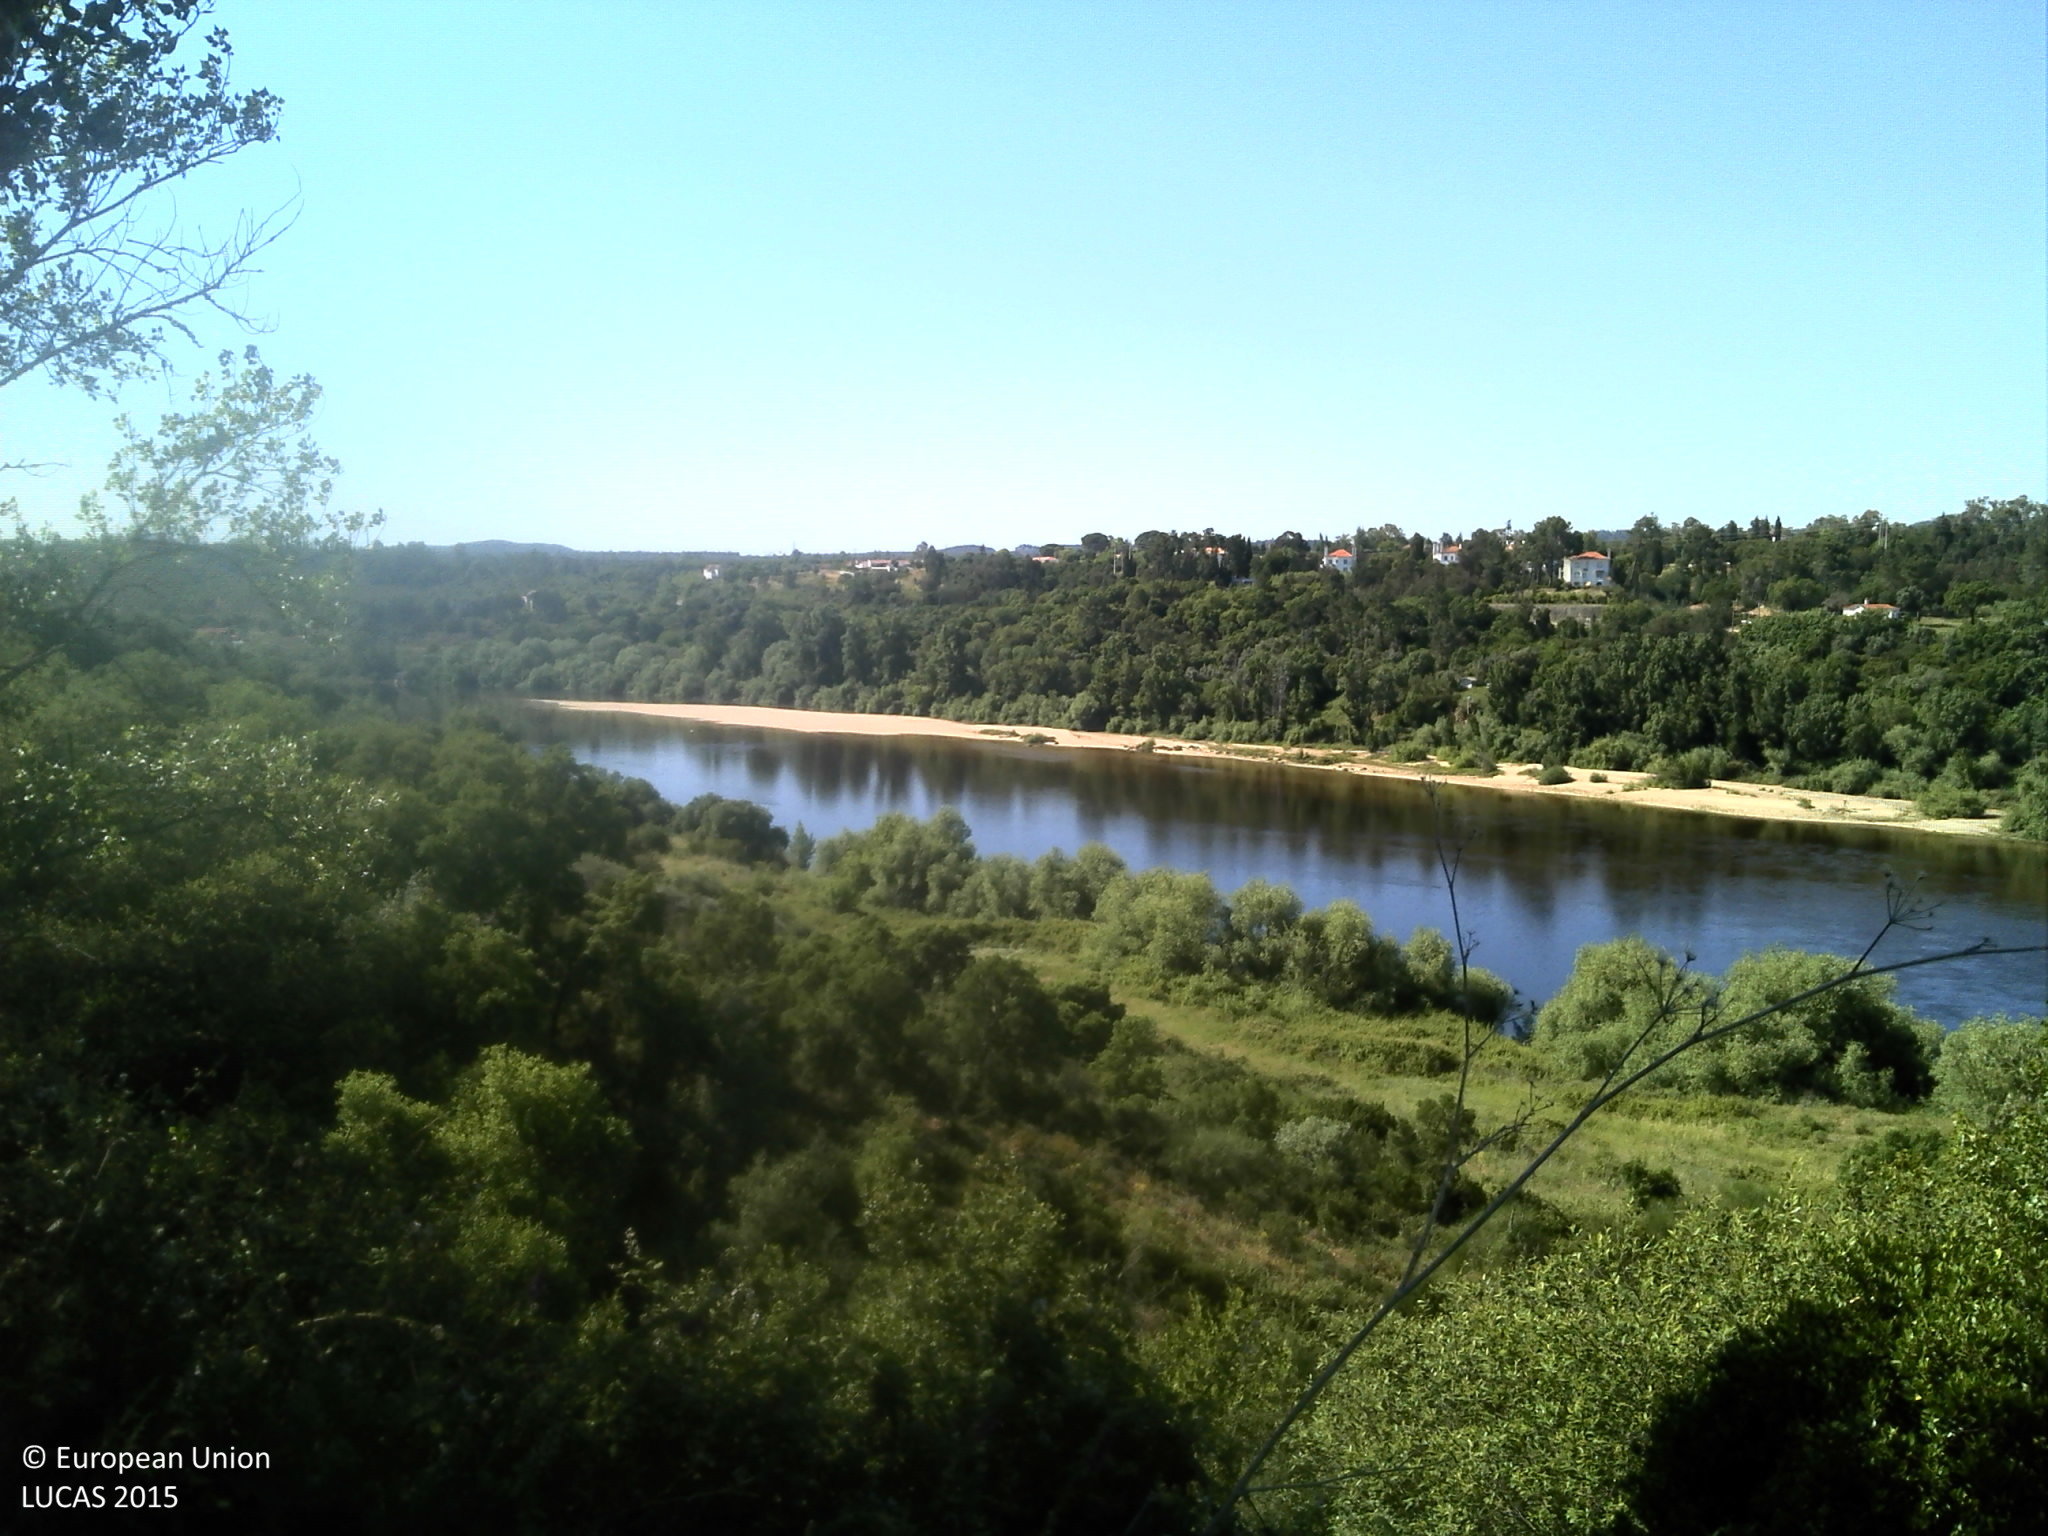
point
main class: Shrubland
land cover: Shrubland with sparse tree cover
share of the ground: > 75 %
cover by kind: shrubs 85 %, herbaceous plants 10 %, broadleaved forest trees 5 %
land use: Abandoned areas
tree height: > 5 m
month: May
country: PT
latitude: 39.4587
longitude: -8.3731
